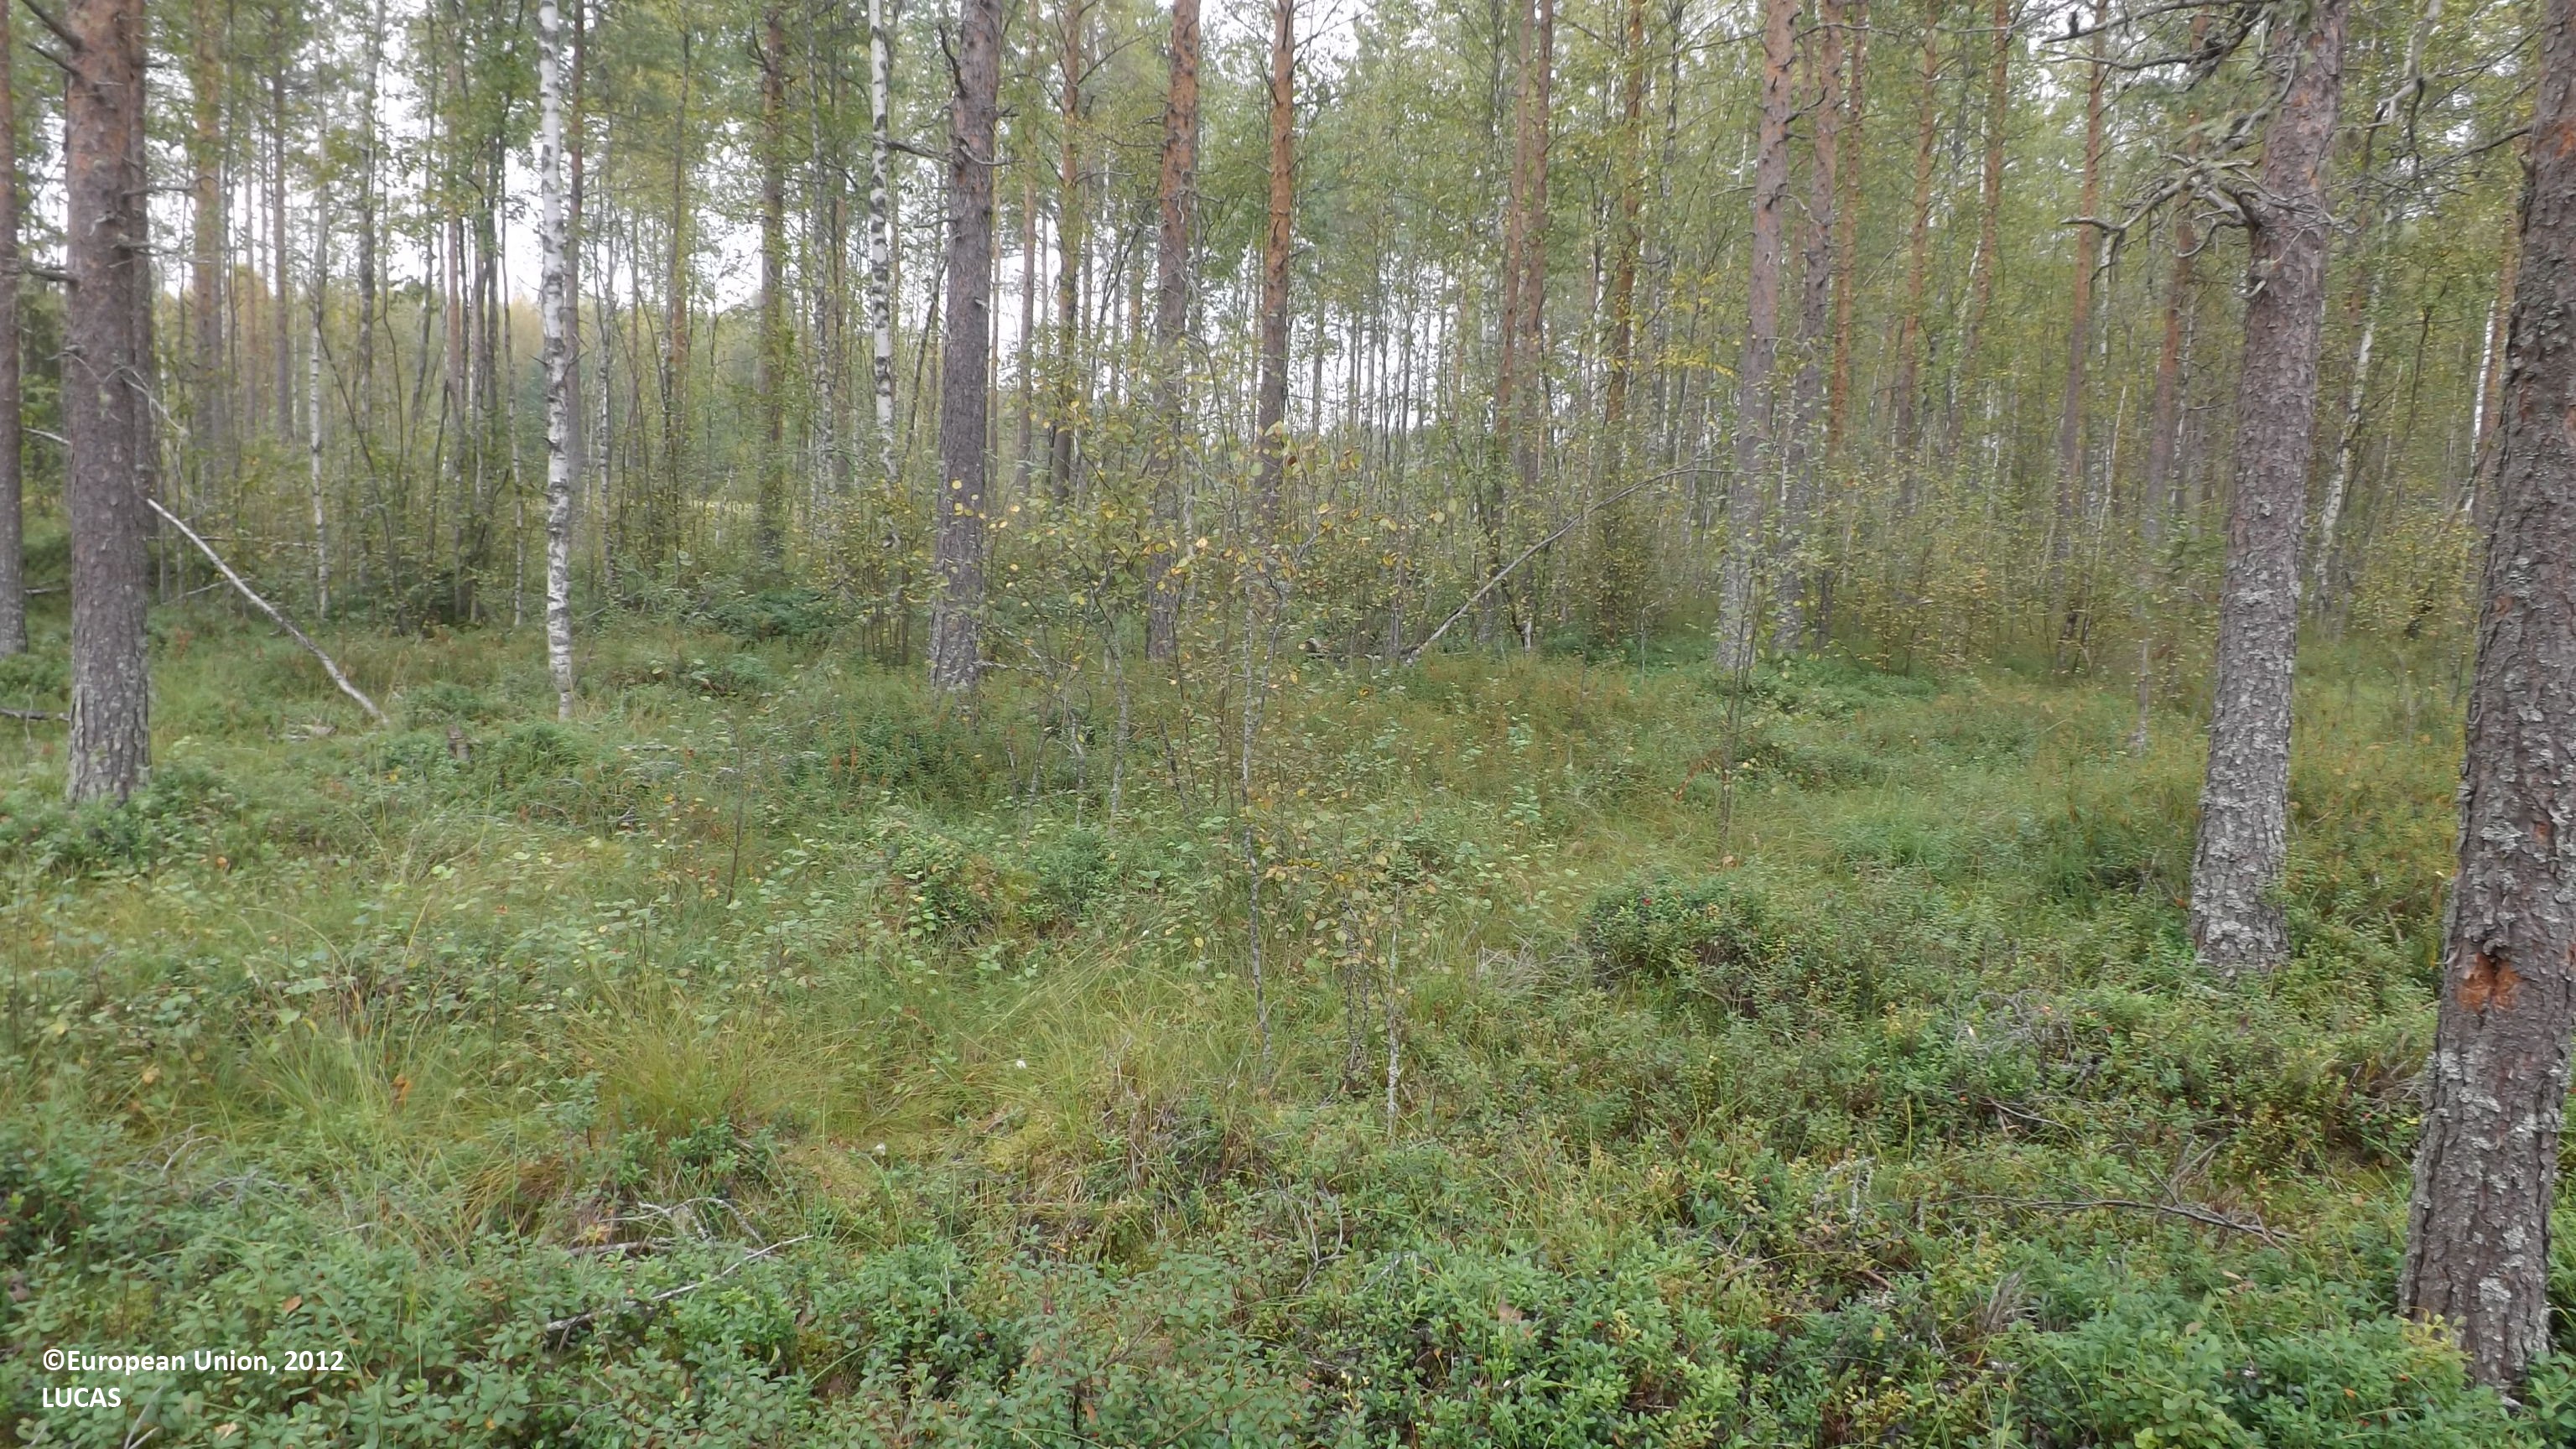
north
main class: Woodland
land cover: Pine dominated mixed woodland
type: boreal forest
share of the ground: 50 - 75 %
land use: Forestry
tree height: > 5 m
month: August
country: FI
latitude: 63.9005
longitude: 23.8153
